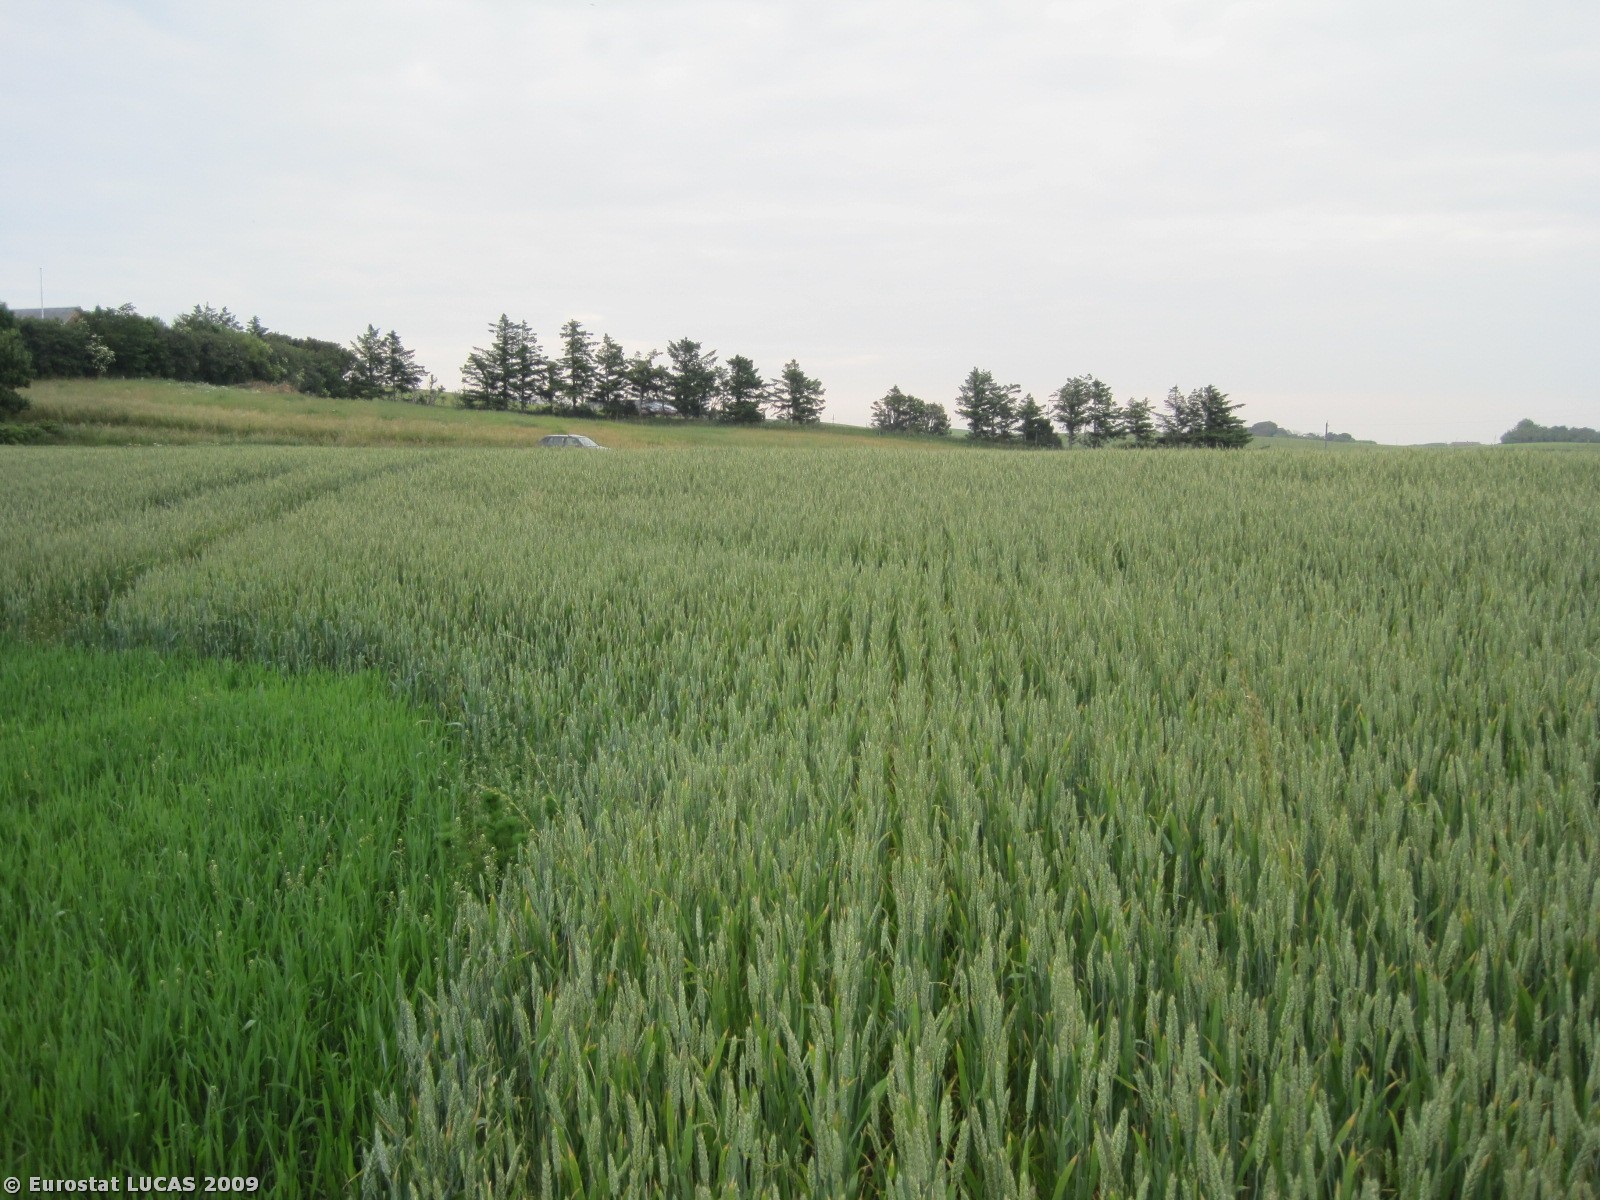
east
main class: Cropland
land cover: Common wheat
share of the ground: > 75 %
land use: Agriculture (excluding fallow land and kitchen gardens)
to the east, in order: Common wheat; Grass margins; Paved roads, cycling and walking lanes; Grassland without tree/shrub cover; Fences; Temporary grasslands; Ditches and canals; Coniferous woodland; Grass margins; Barley
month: June
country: DK
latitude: 56.5549
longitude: 8.3589
